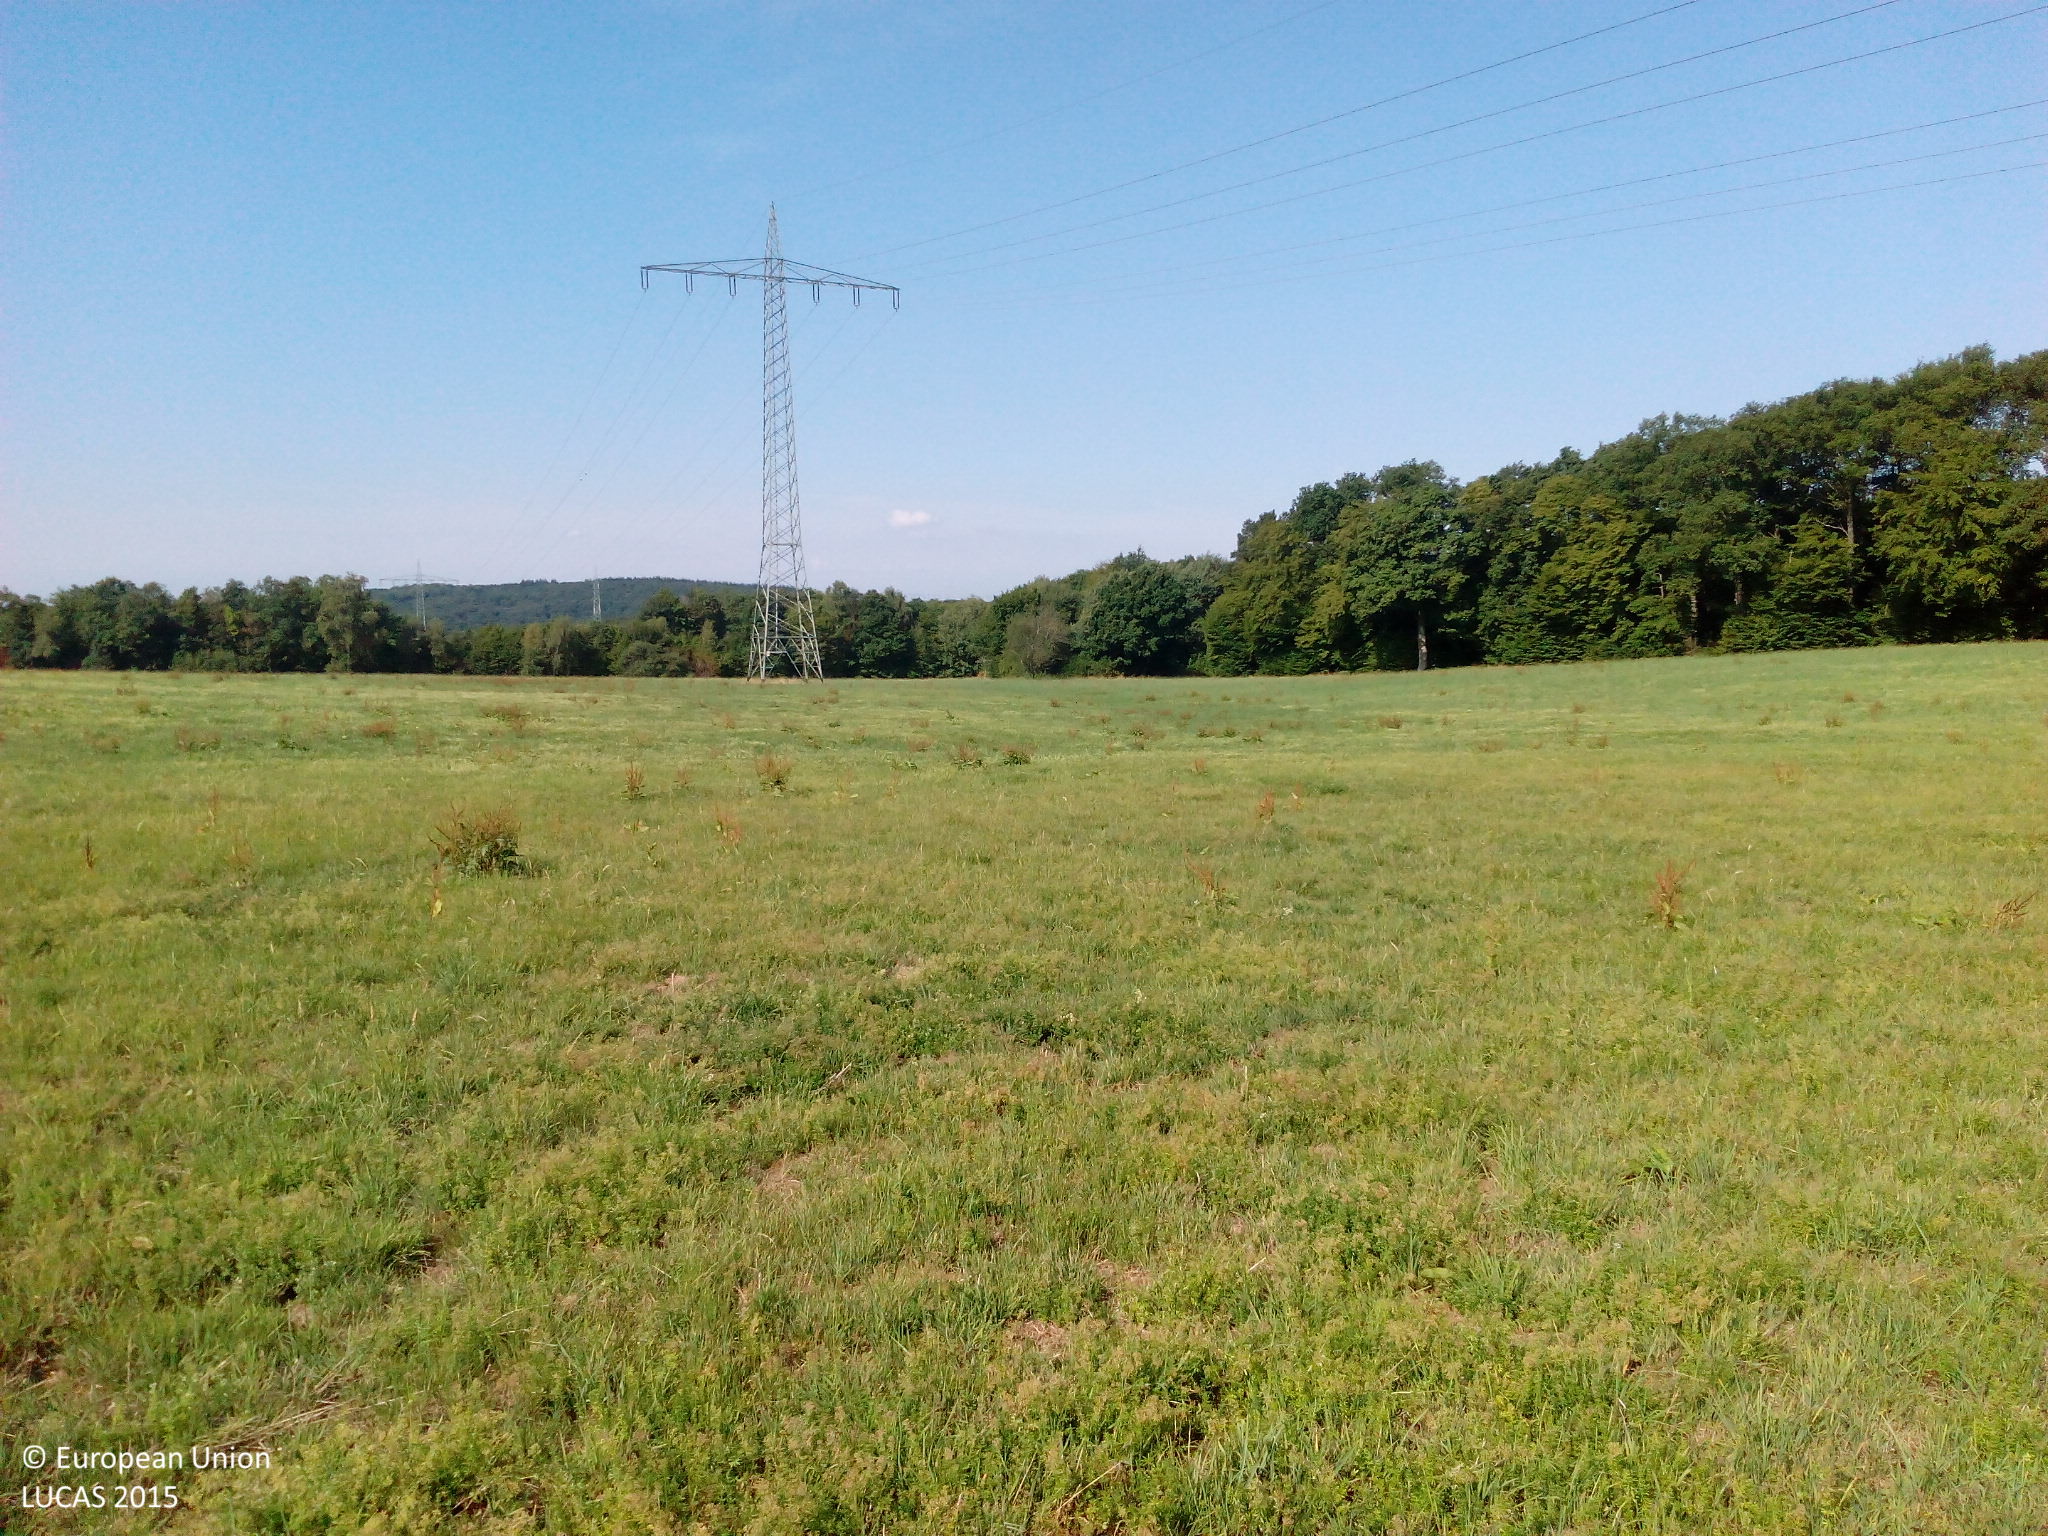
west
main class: Grassland
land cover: Grassland without tree/shrub cover
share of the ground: > 75 %
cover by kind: herbaceous plants 90 %, unconsolidated bare surface 10 %
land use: Agriculture (excluding fallow land and kitchen gardens)
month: August
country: DE
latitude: 50.2652
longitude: 7.5172
